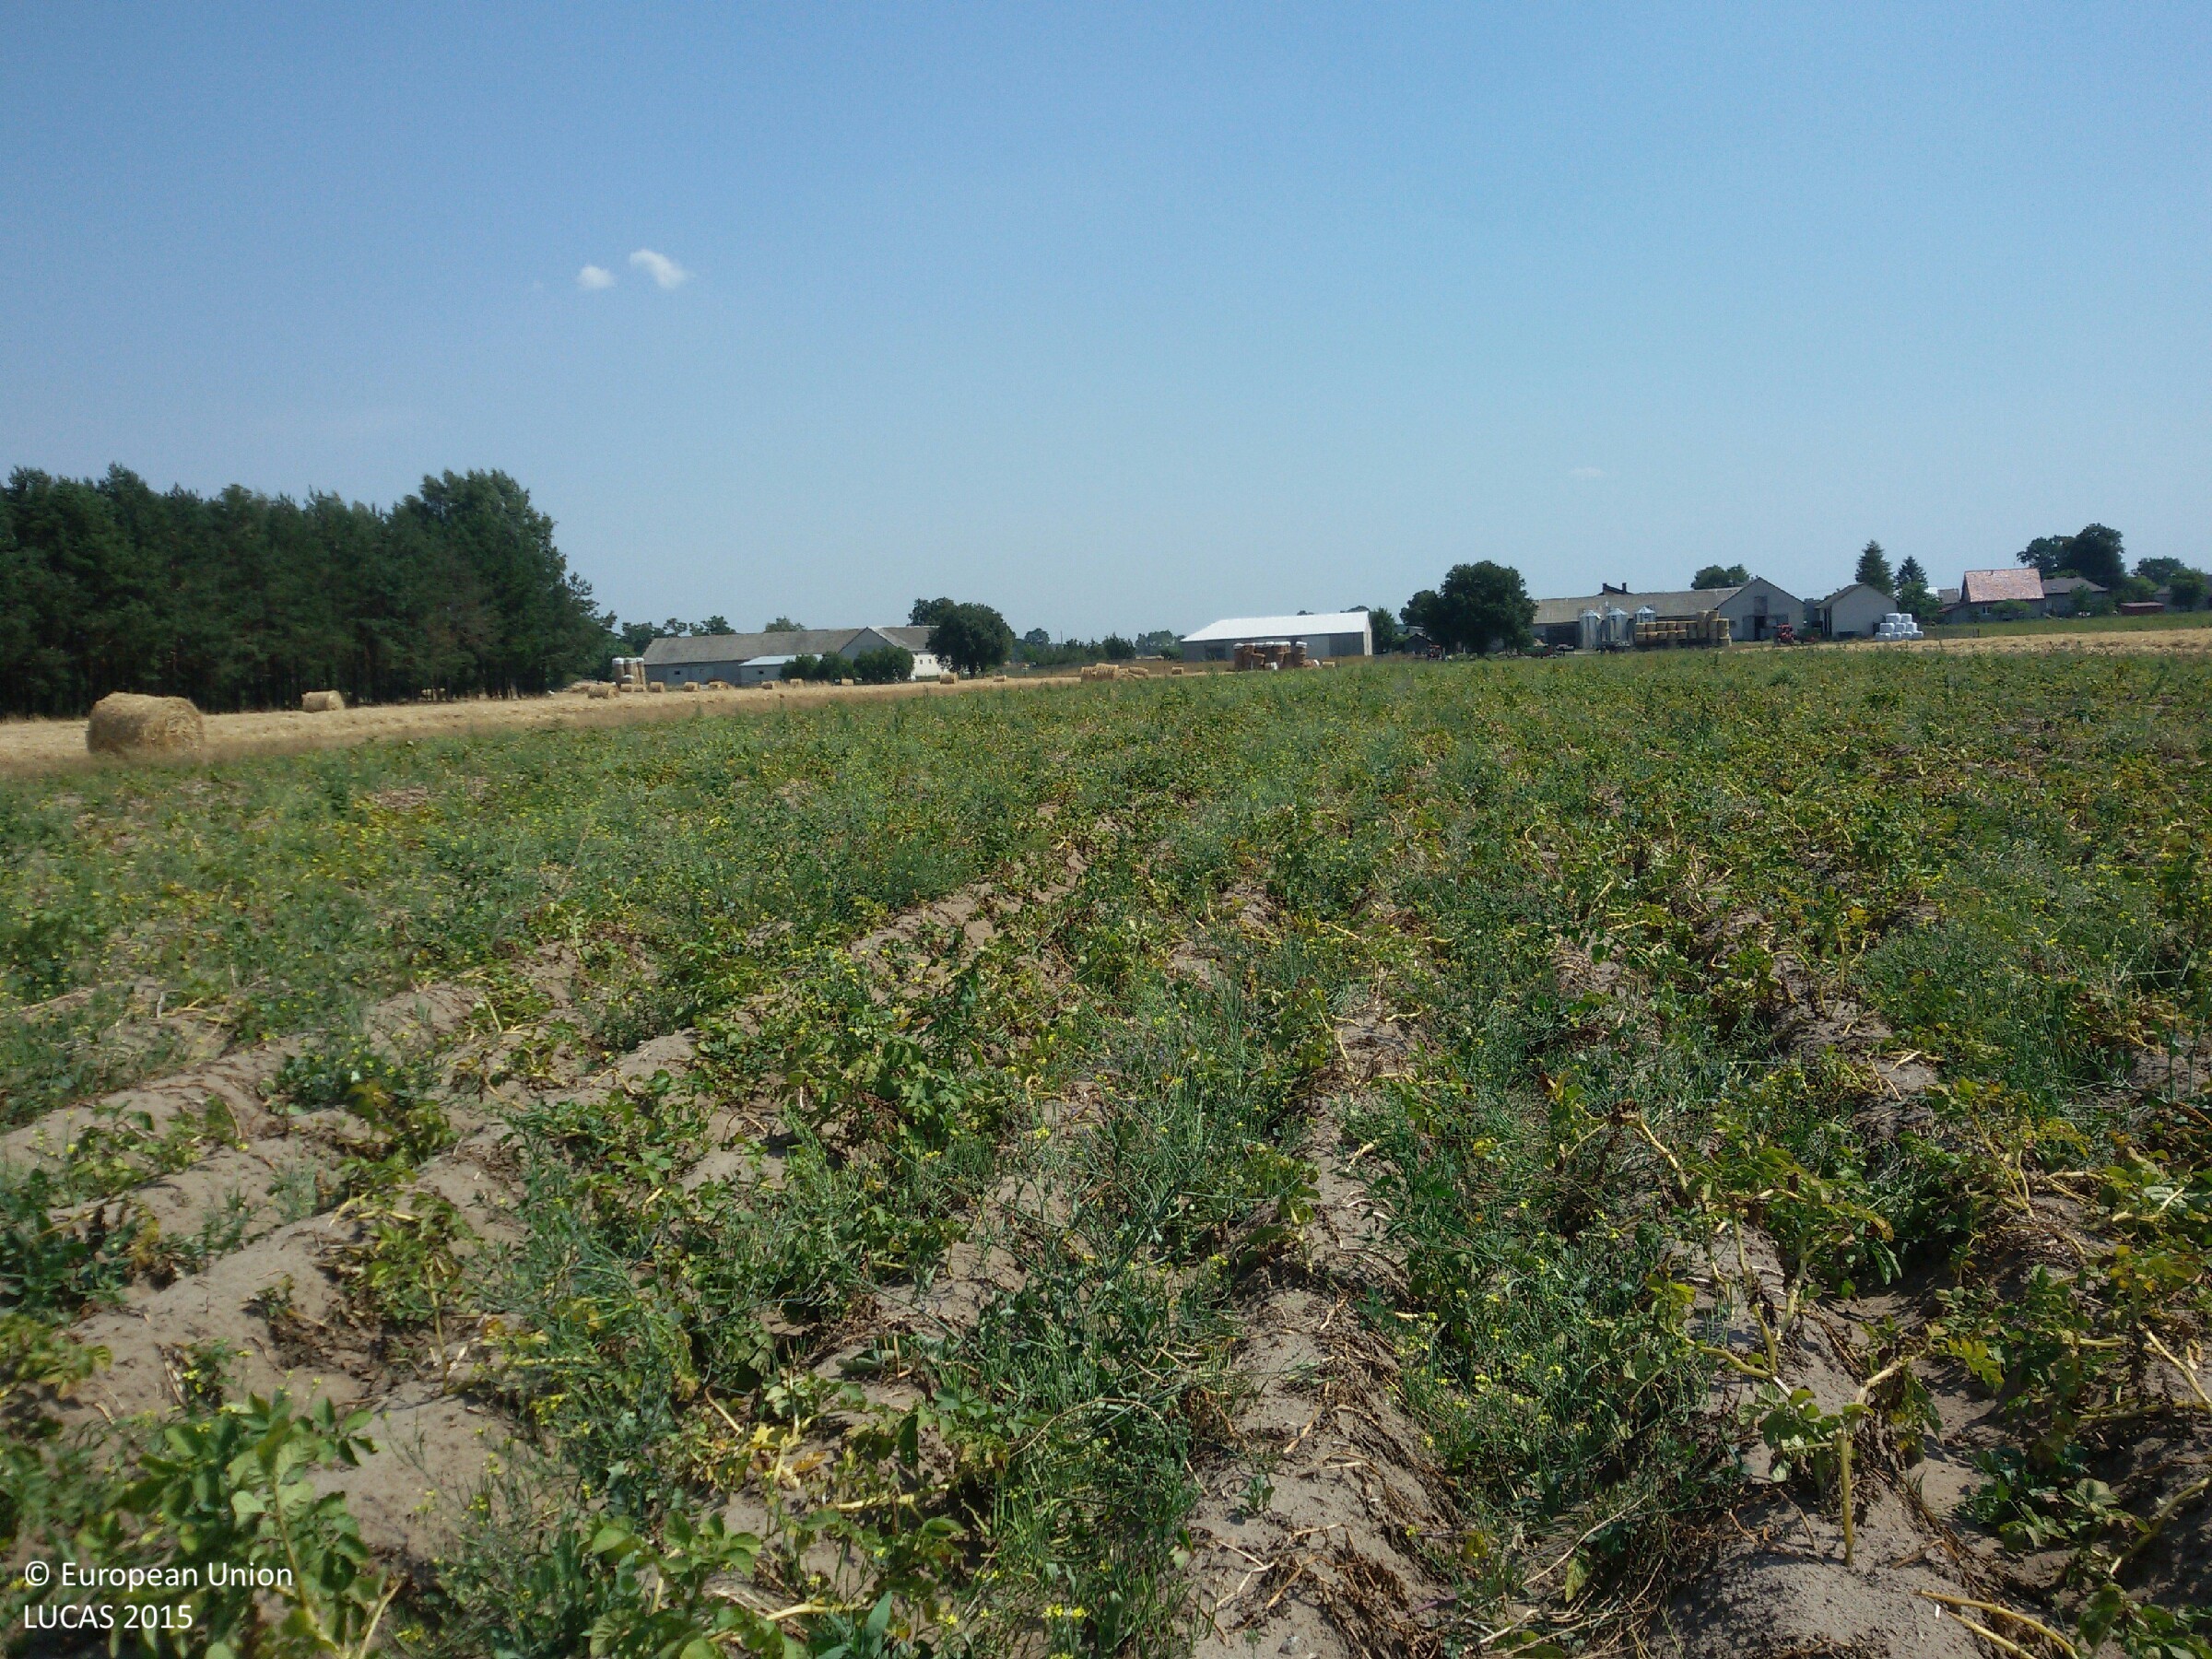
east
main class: Cropland
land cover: Potatoes
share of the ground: > 75 %
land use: Agriculture (excluding fallow land and kitchen gardens)
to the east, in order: Potatoes; Rye; Grass margins; Rye
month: August
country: PL
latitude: 52.5853
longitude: 21.2498
